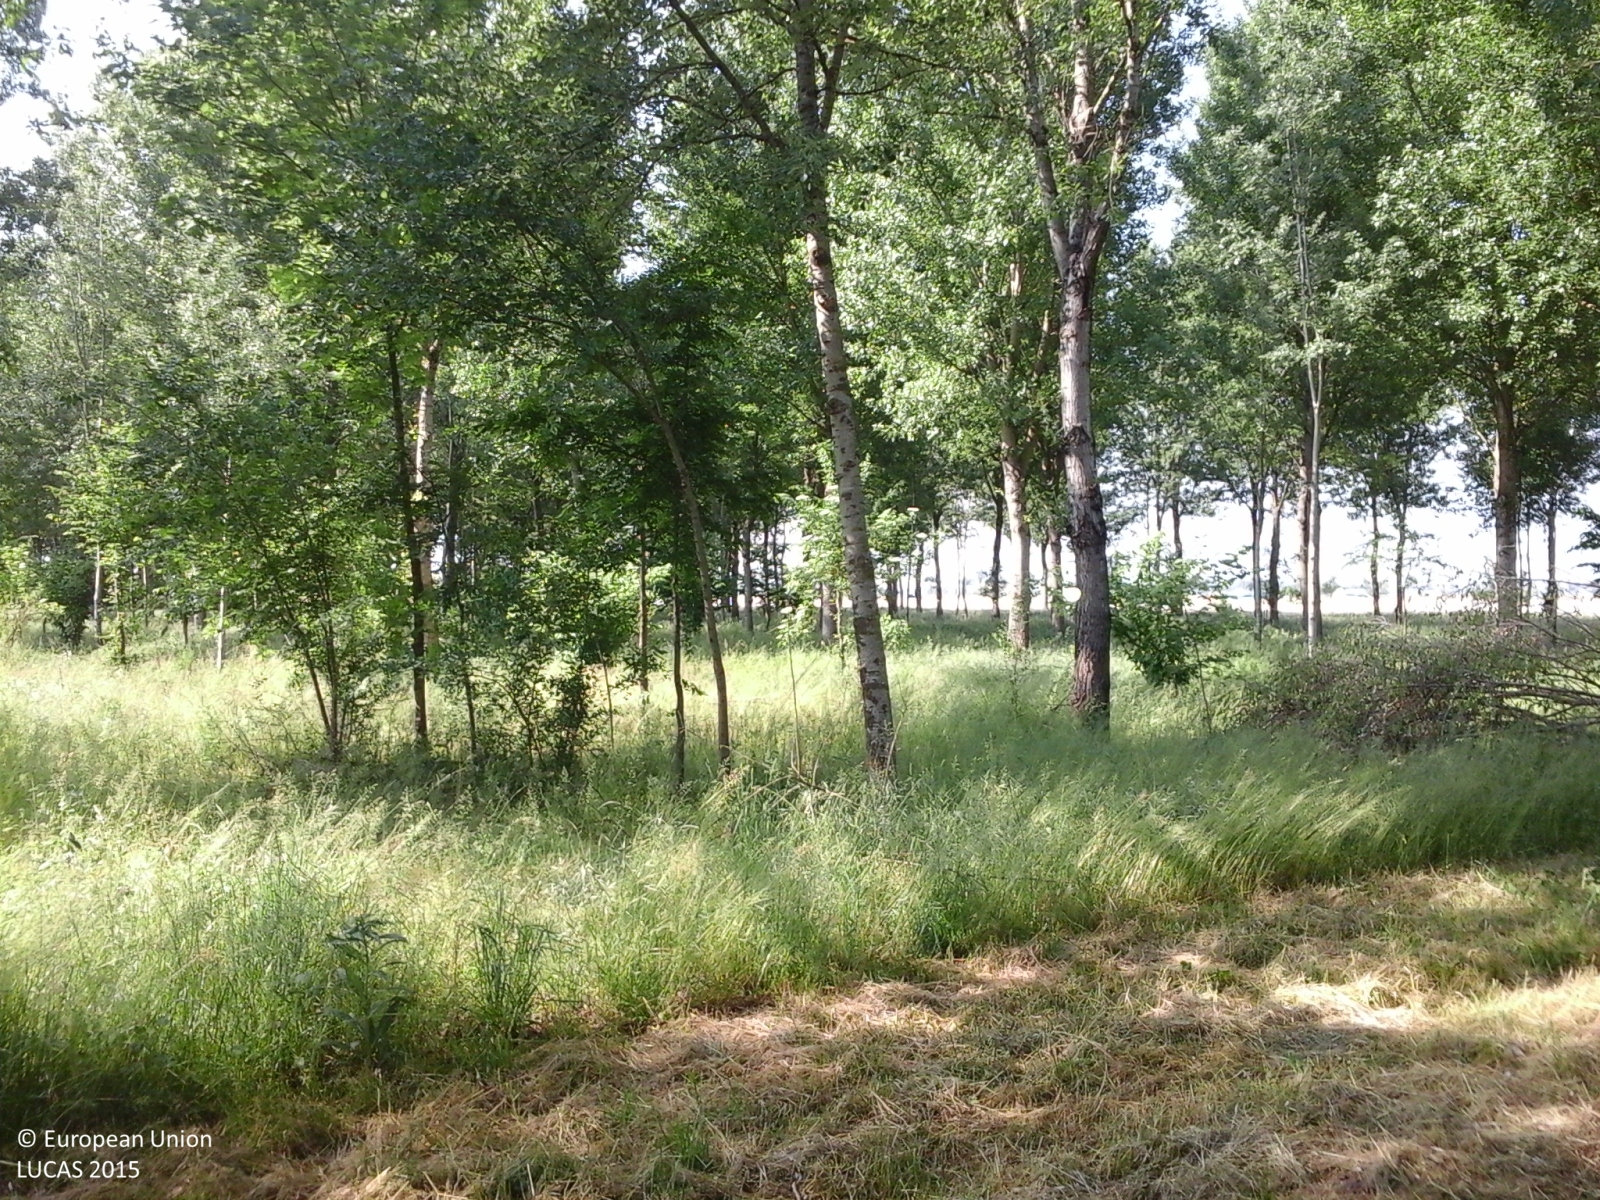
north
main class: Woodland
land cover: Broadleaved woodland
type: floodplain forest
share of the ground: 25 - 50 %
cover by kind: broadleaved forest trees 50 %, herbaceous plants 50 %
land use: Forestry
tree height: > 5 m
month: May
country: IT
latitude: 45.2122
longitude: 9.0976
